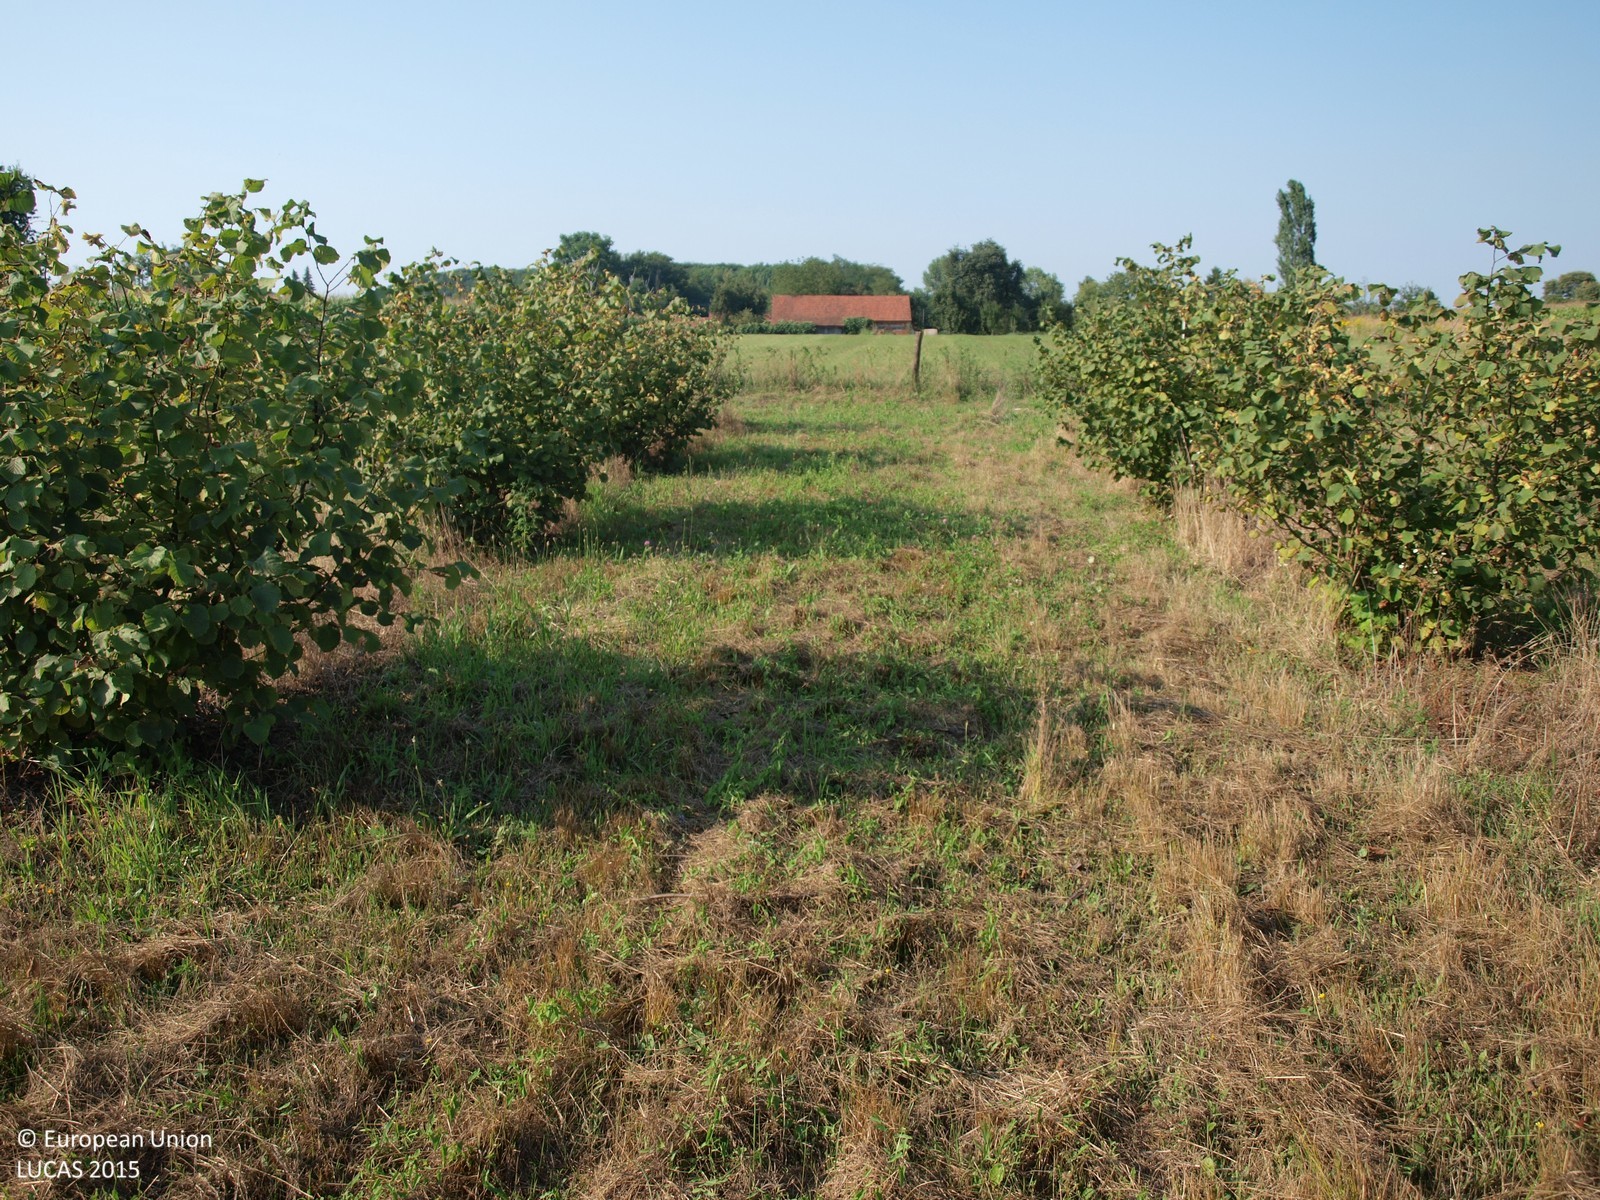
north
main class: Cropland
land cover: Nuts trees
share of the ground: 25 - 50 %
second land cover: Grassland without tree/shrub cover
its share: > 75 %
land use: Agriculture (excluding fallow land and kitchen gardens)
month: August
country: HR
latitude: 45.8414
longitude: 16.5789
